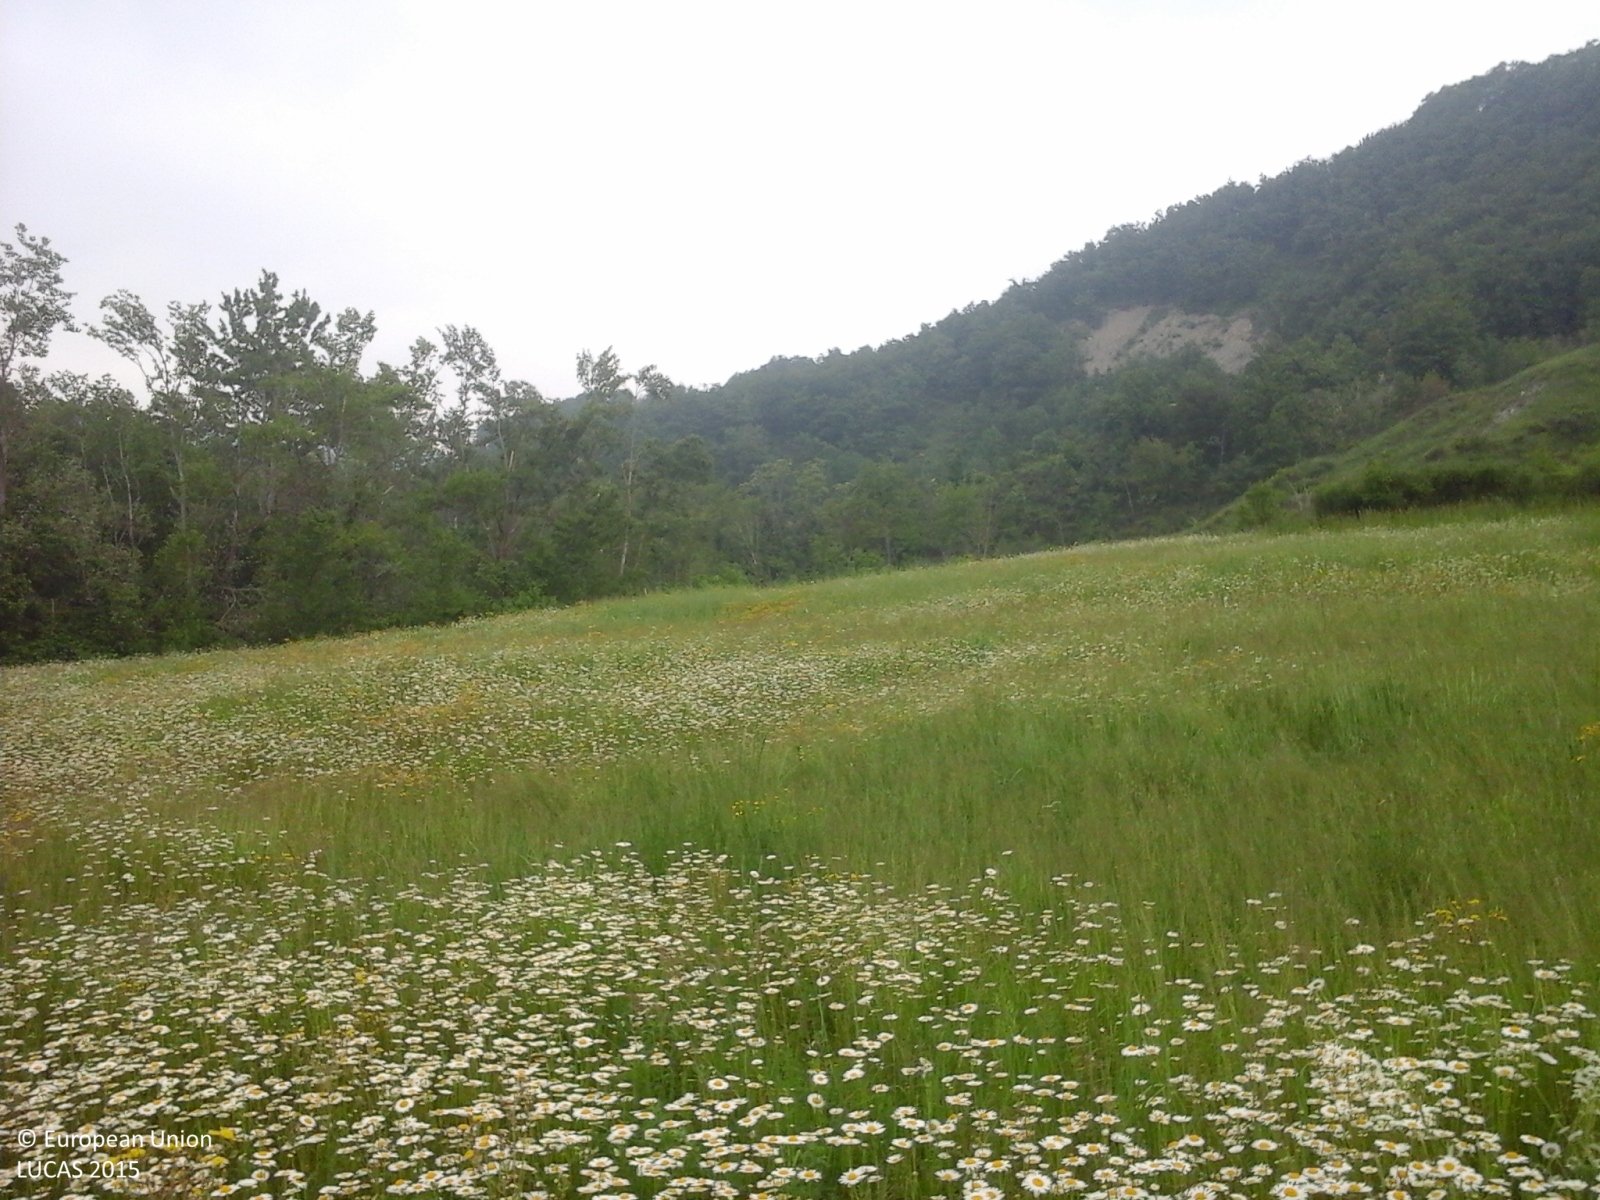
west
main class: Cropland
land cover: Lucerne
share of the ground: 50 - 75 %
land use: Agriculture (excluding fallow land and kitchen gardens)
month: May
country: IT
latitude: 44.3812
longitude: 11.0645
